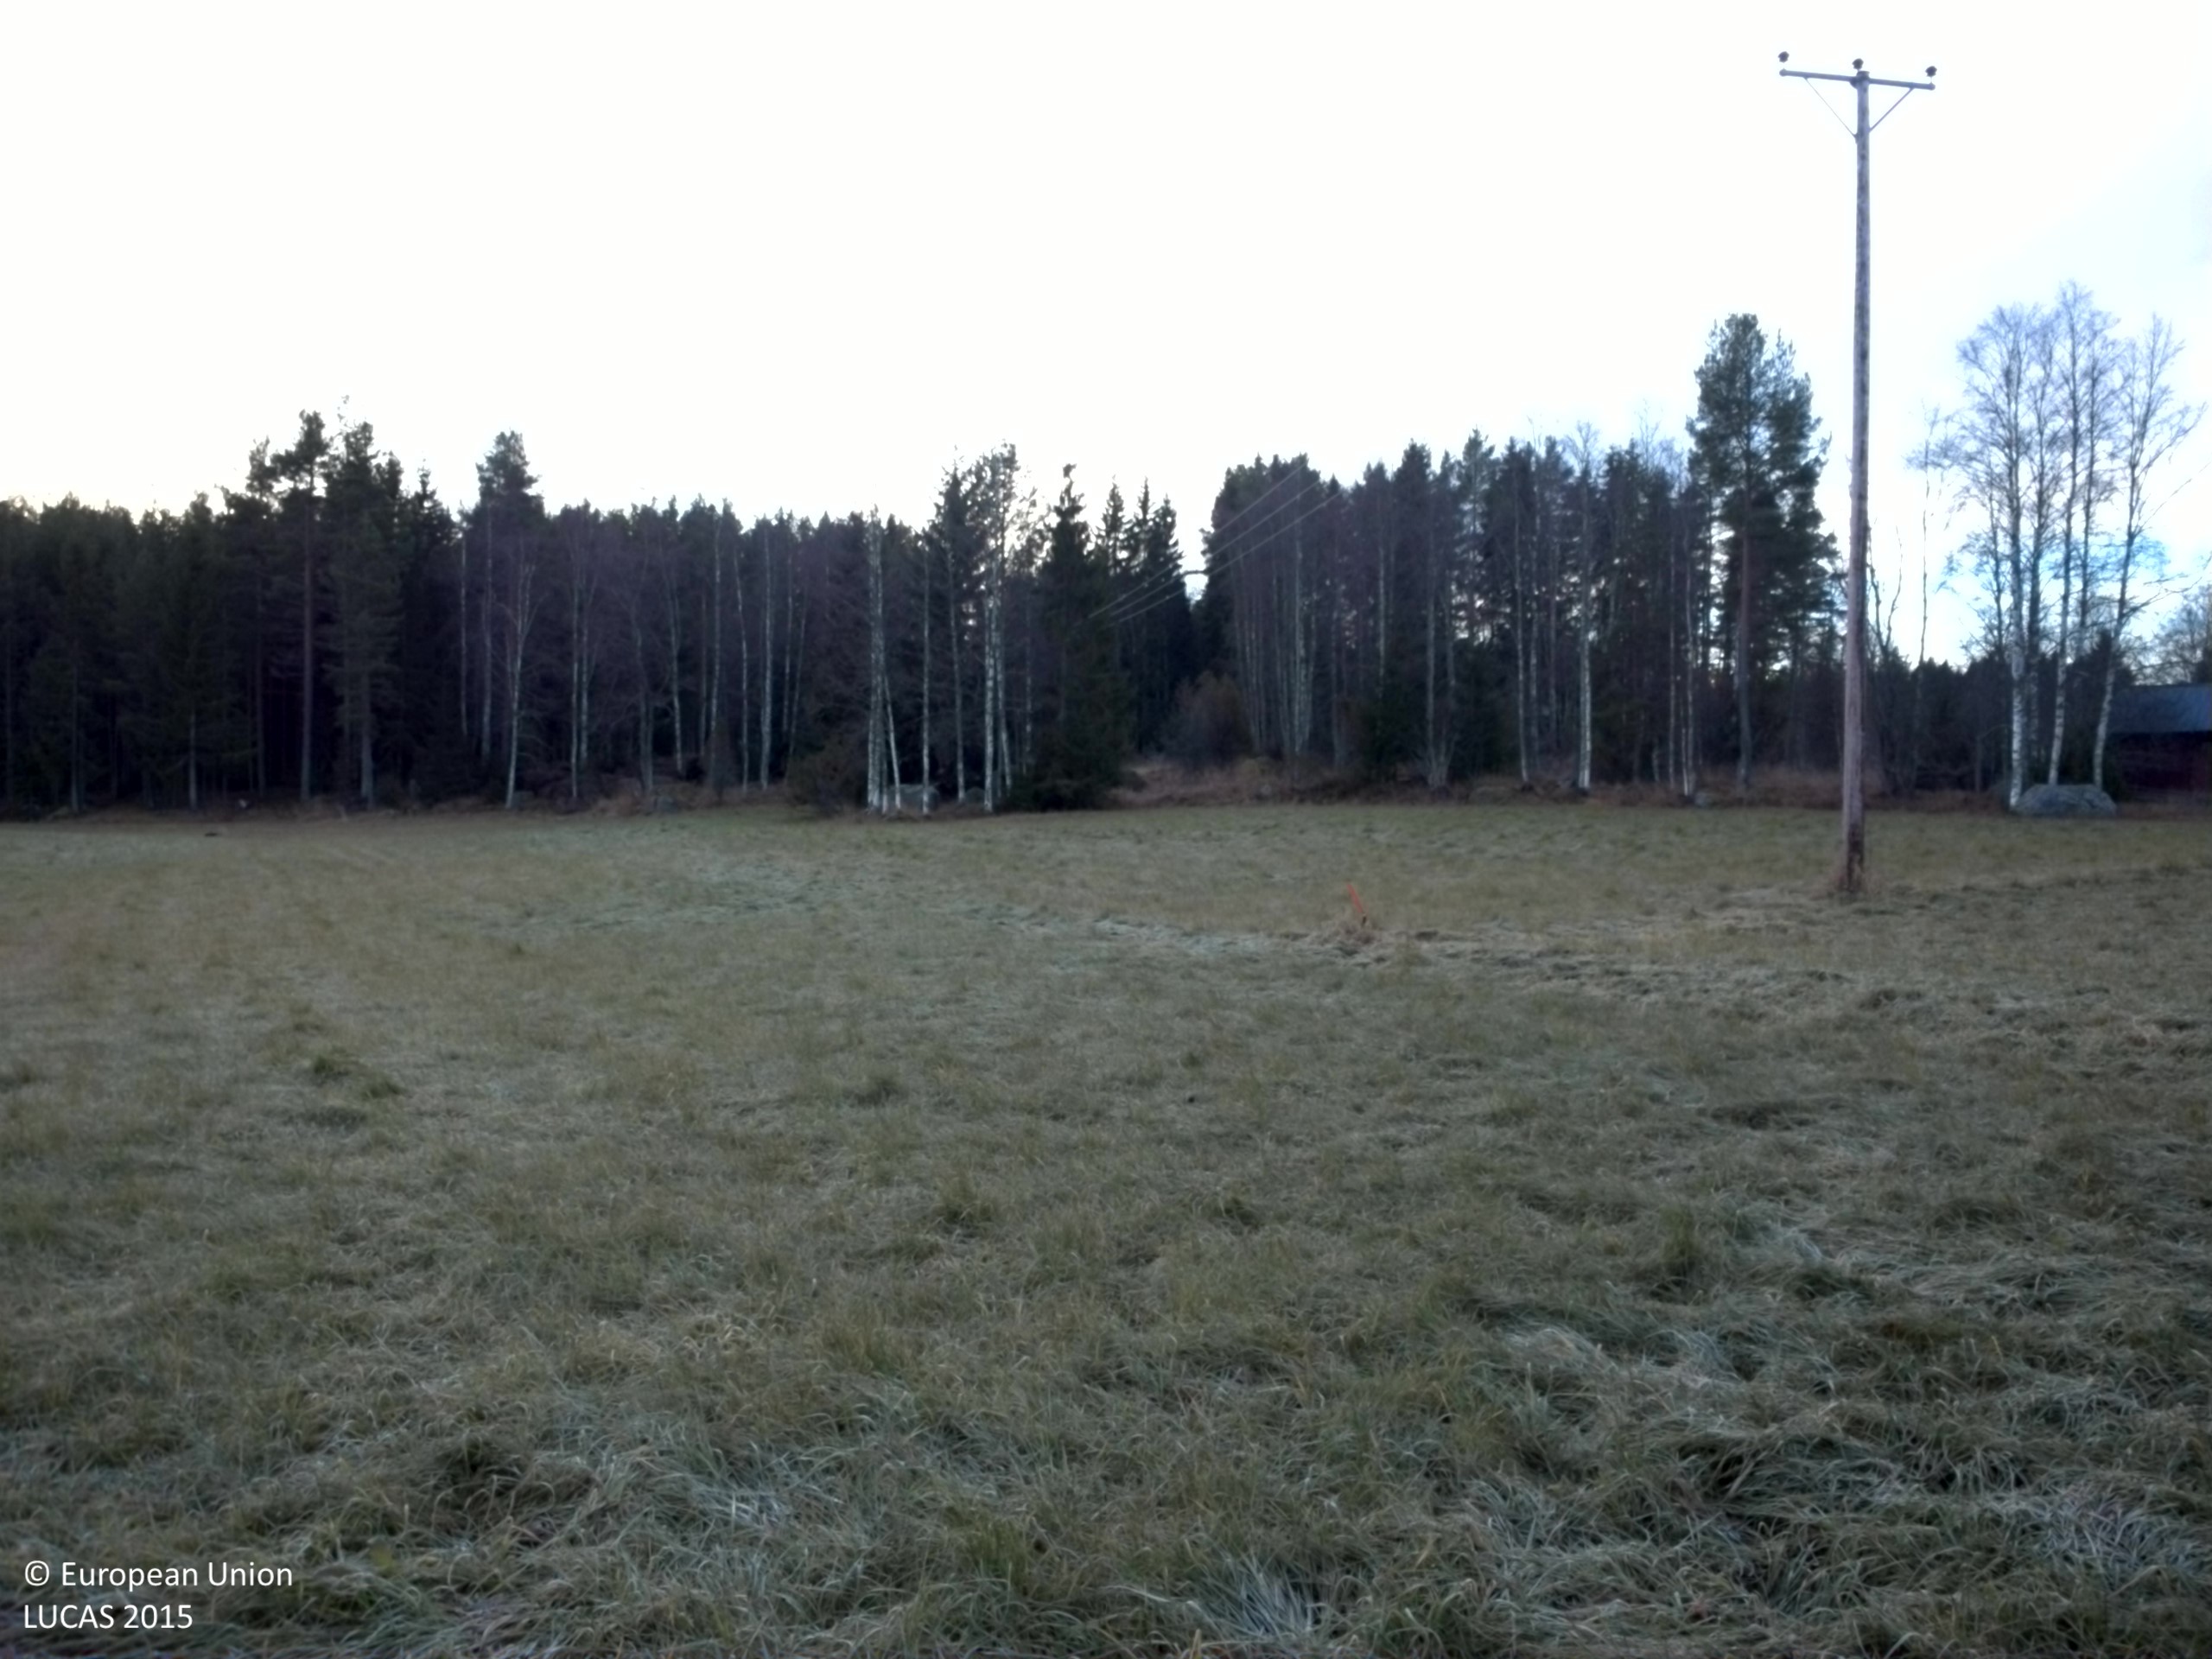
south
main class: Cropland
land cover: Other leguminous and mixtures for fodder
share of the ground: > 75 %
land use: Agriculture (excluding fallow land and kitchen gardens)
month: November
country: SE
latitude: 61.2783
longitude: 16.4954
